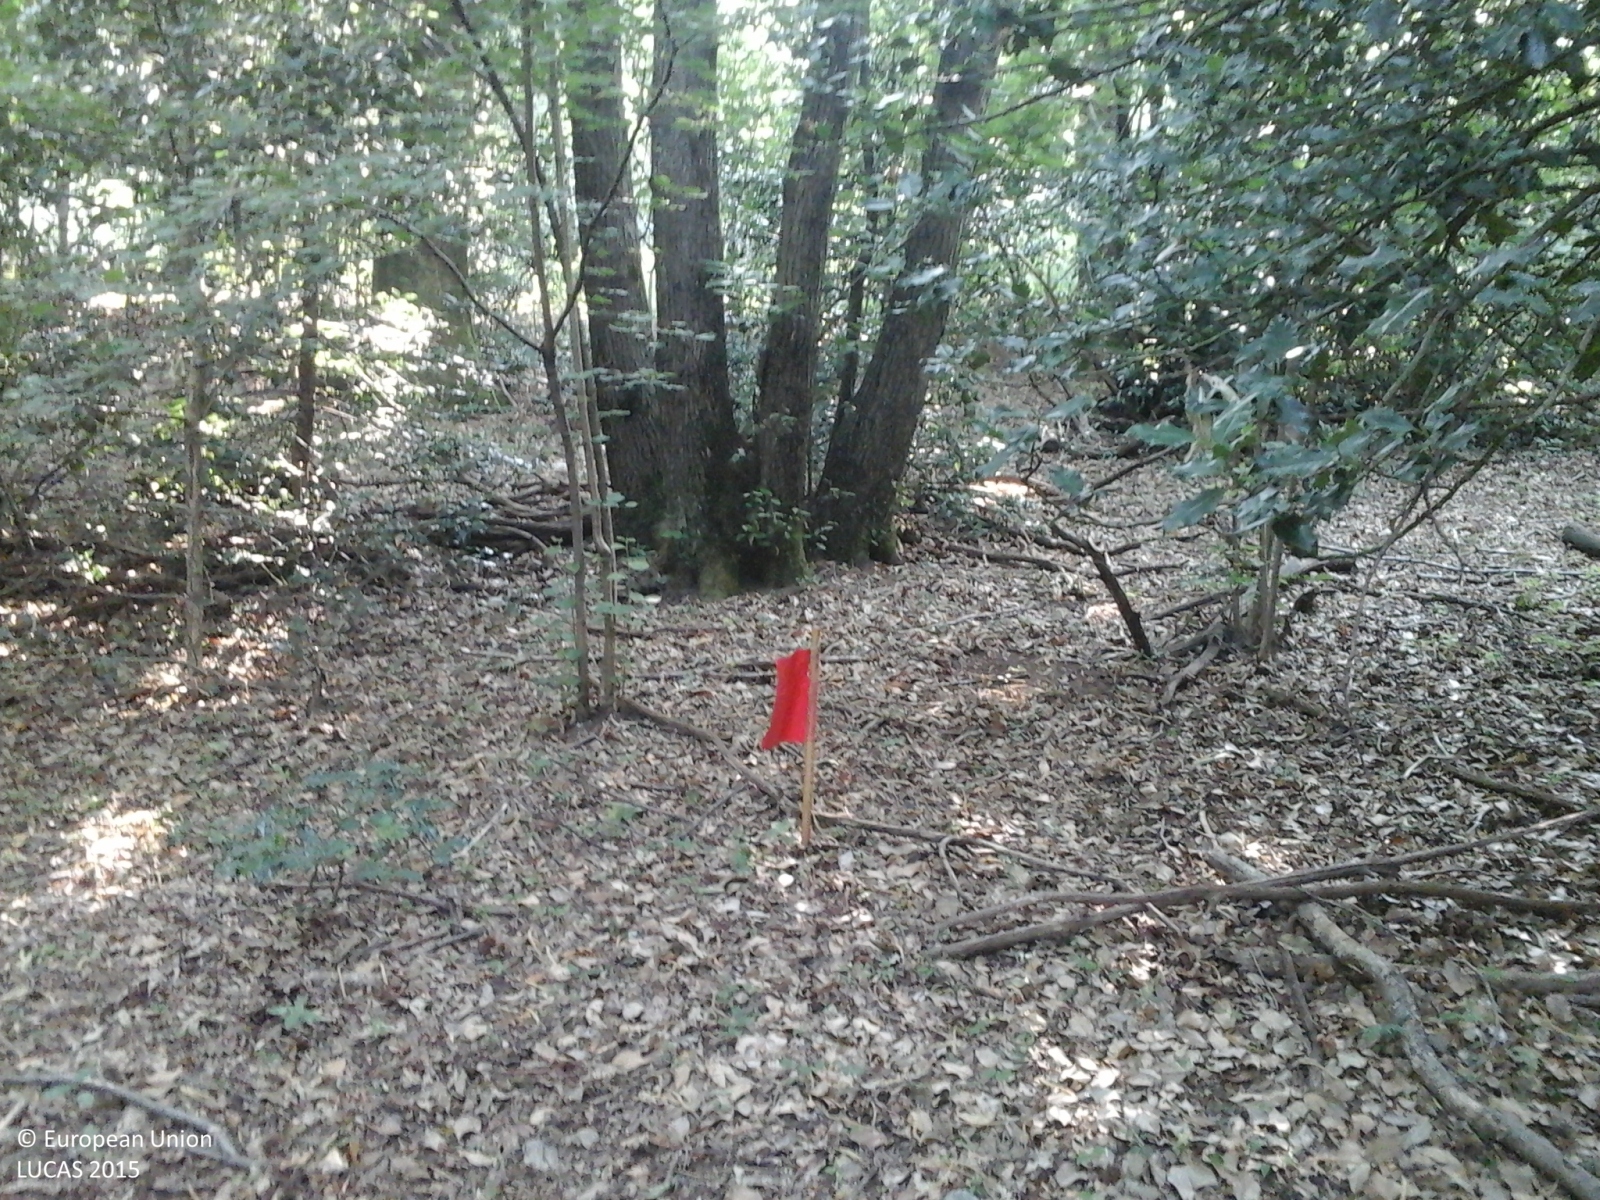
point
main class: Woodland
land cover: Broadleaved woodland
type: thermophilous deciduous forest
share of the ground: > 75 %
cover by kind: broadleaved forest trees 100 %
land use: Forestry
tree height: > 5 m
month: July
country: IT
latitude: 46.0379
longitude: 8.7742
